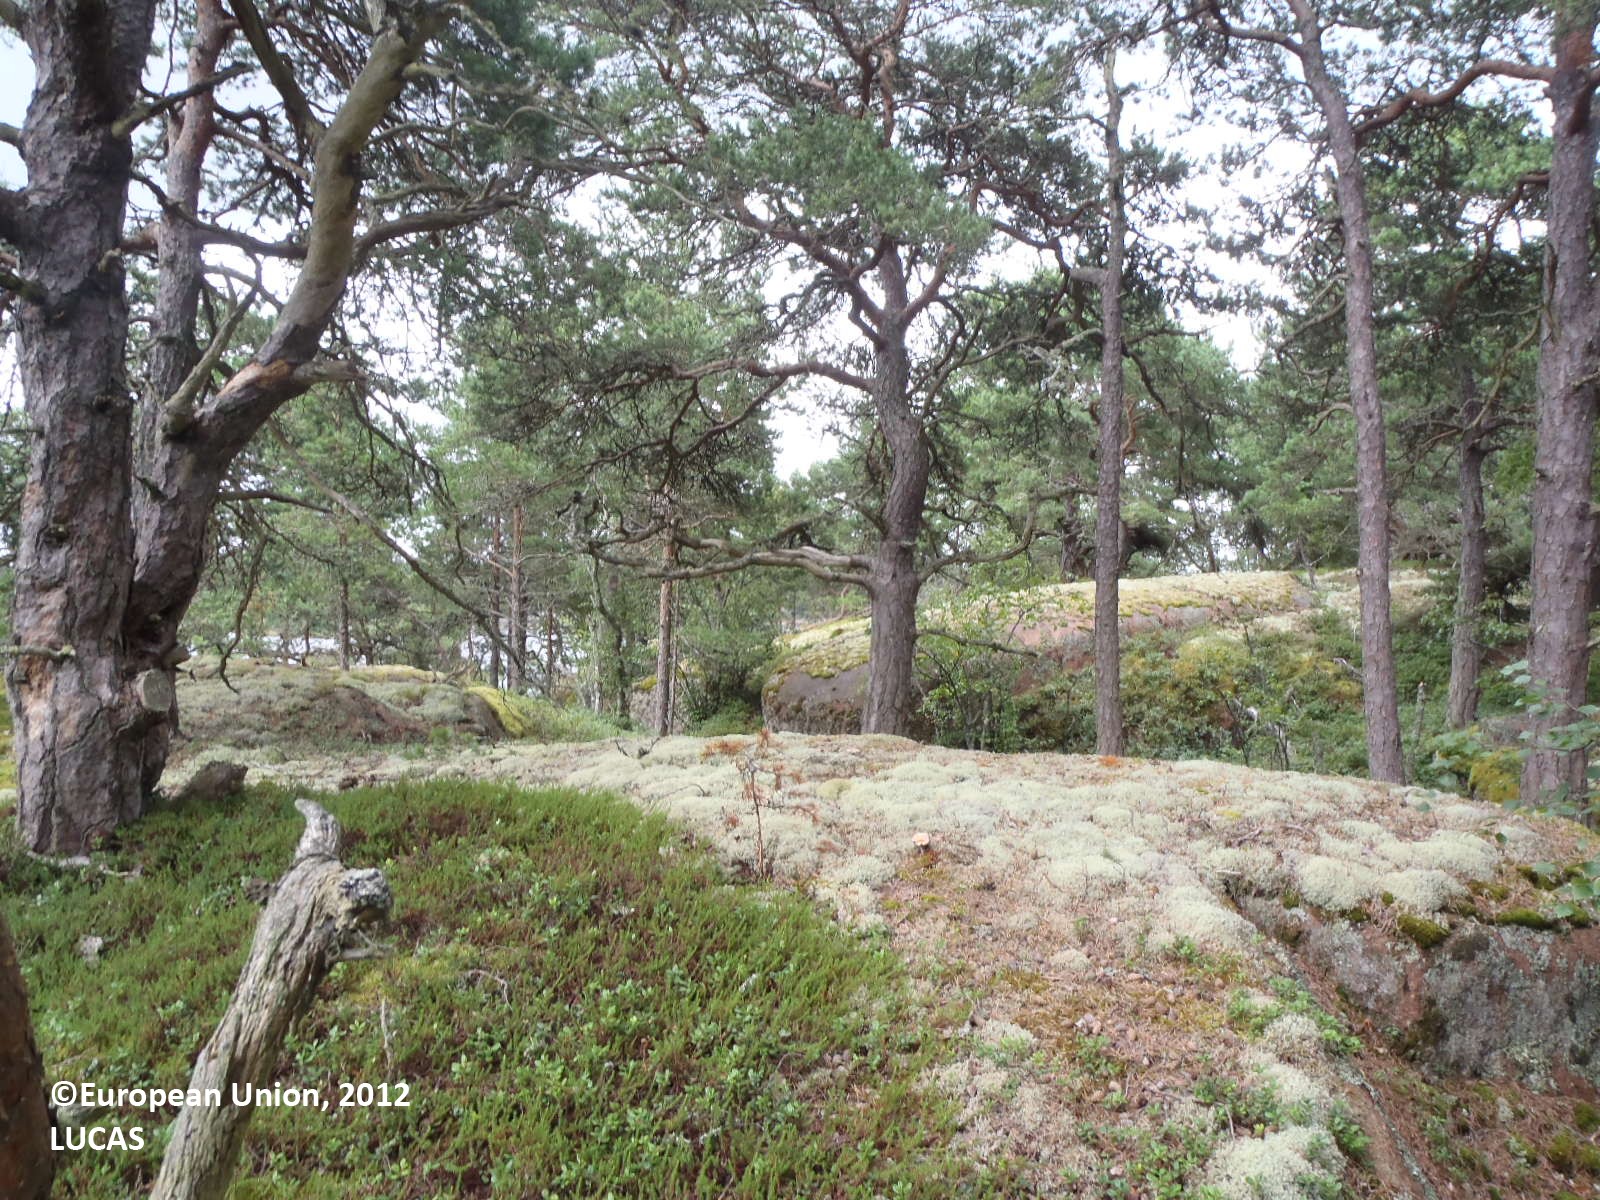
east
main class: Woodland
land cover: Pine dominated coniferous woodland
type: boreal forest
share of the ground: 50 - 75 %
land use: Semi-natural and natural areas not in use
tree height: > 5 m
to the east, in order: Pine dominated coniferous woodland; Rocks and stones; Pine dominated coniferous woodland
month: August
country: FI
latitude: 59.9911
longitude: 20.2095
